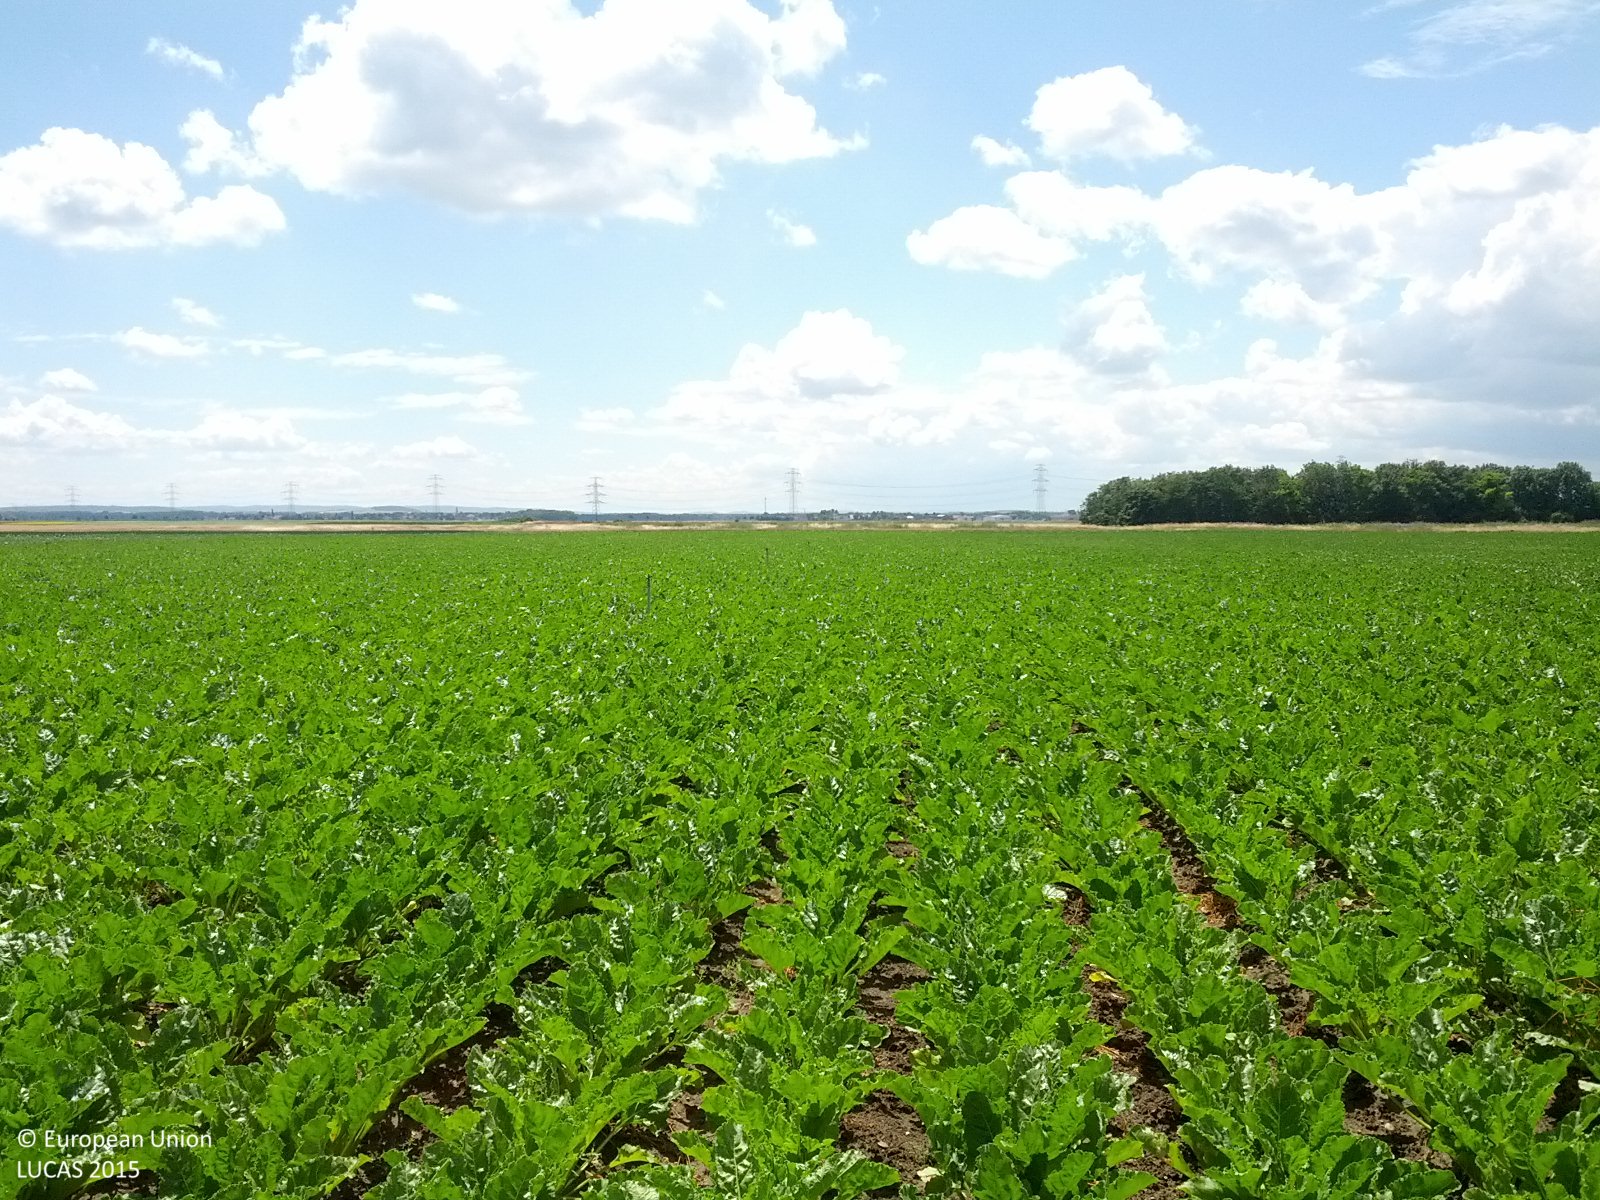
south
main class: Cropland
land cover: Sugar beet
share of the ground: > 75 %
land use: Agriculture (excluding fallow land and kitchen gardens)
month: June
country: AT
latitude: 48.2055
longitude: 16.6128
